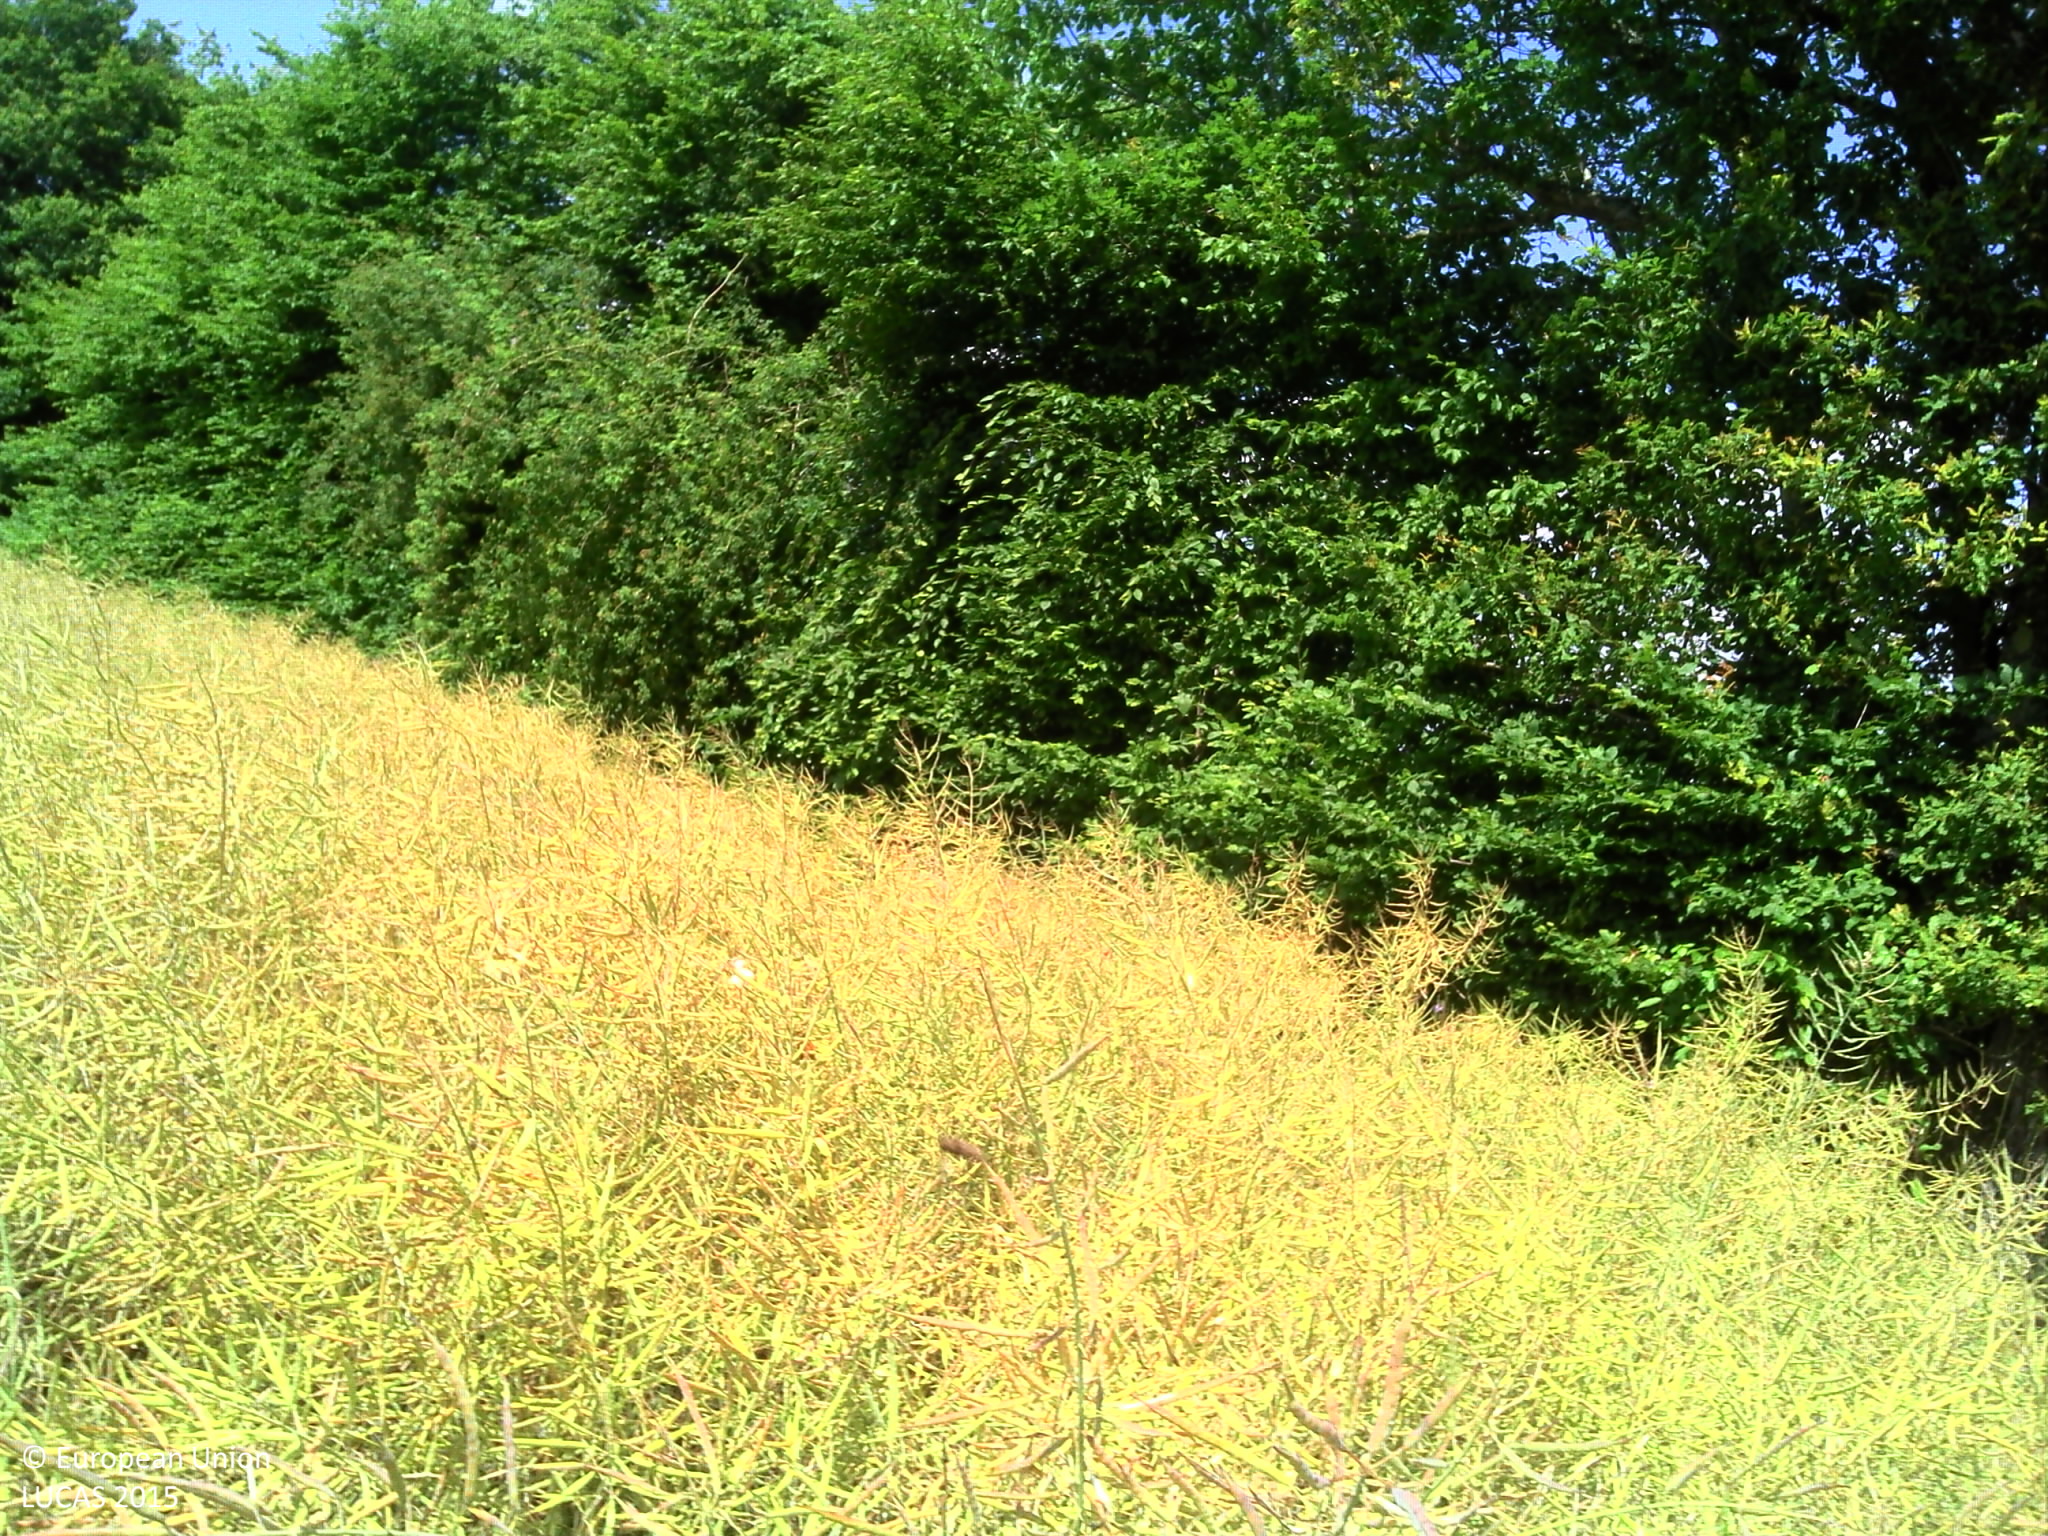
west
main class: Cropland
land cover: Rape and turnip rape
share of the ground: > 75 %
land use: Agriculture (excluding fallow land and kitchen gardens)
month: June
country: FR
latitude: 47.4492
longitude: 2.5788
